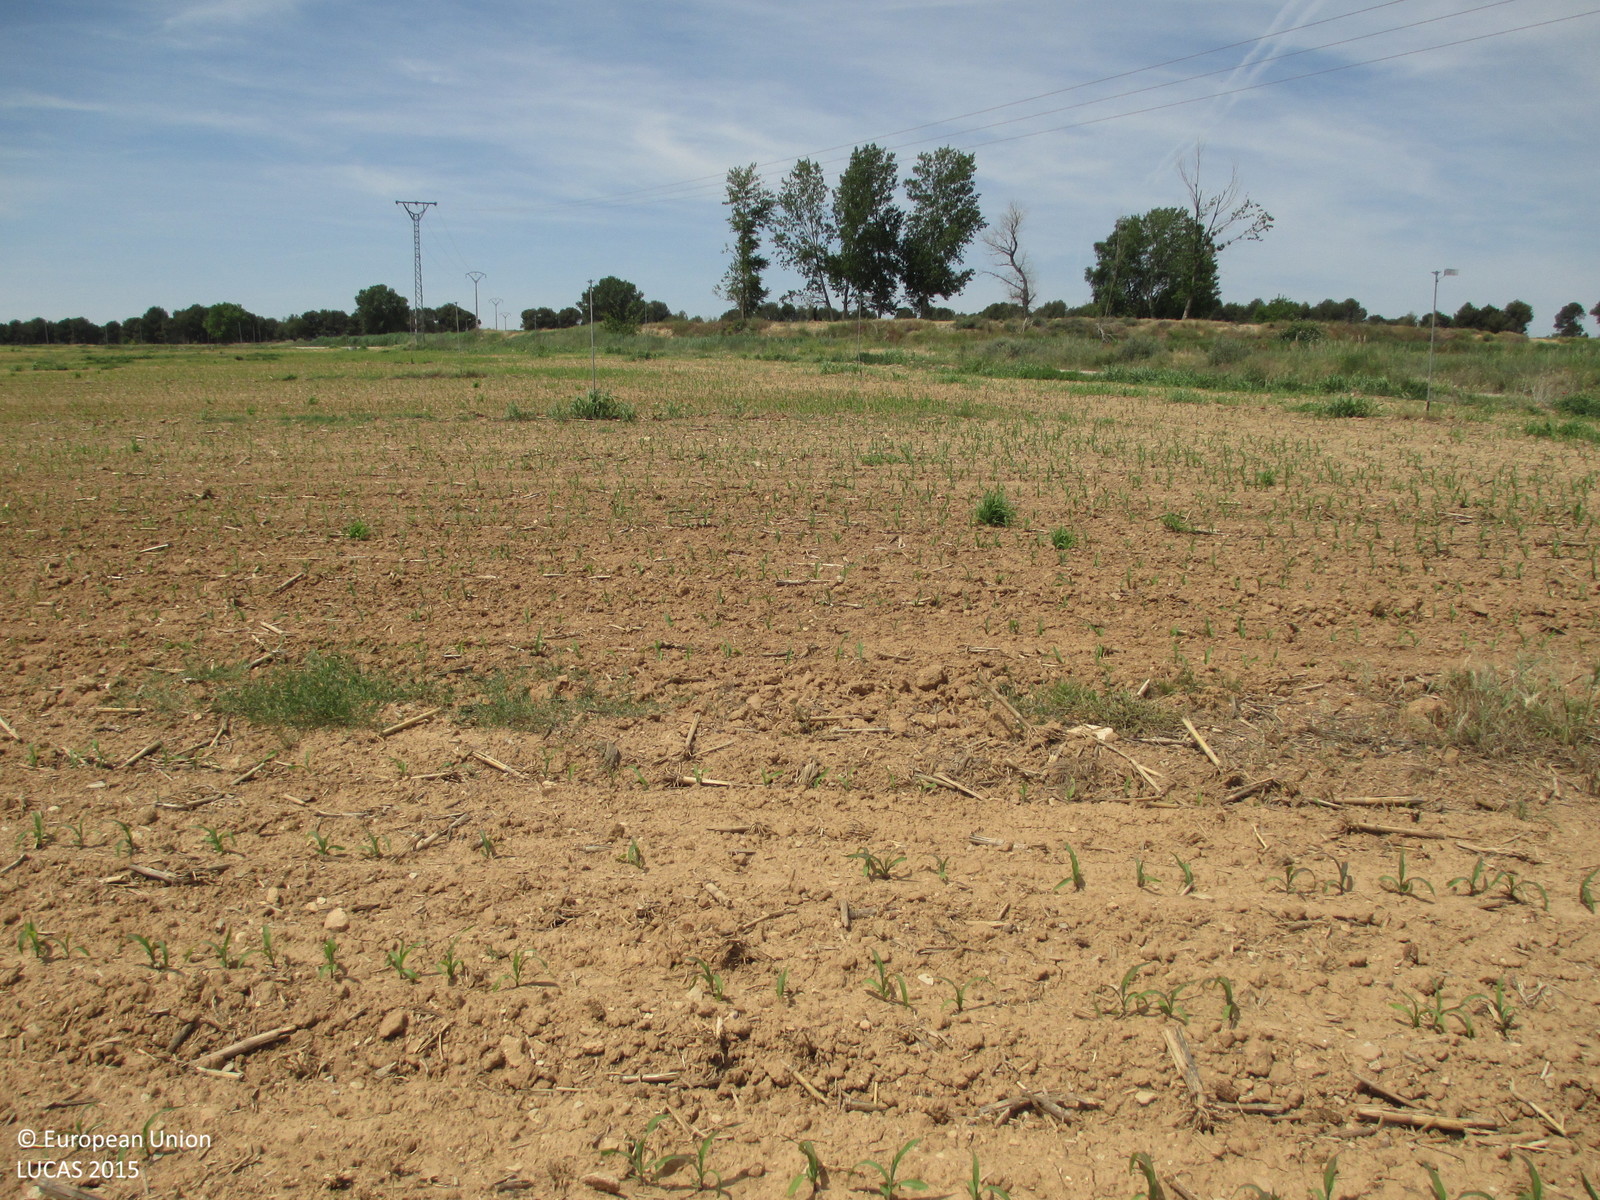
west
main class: Cropland
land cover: Maize
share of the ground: < 10 %
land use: Agriculture (excluding fallow land and kitchen gardens)
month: May
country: ES
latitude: 41.8682
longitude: -0.3449
